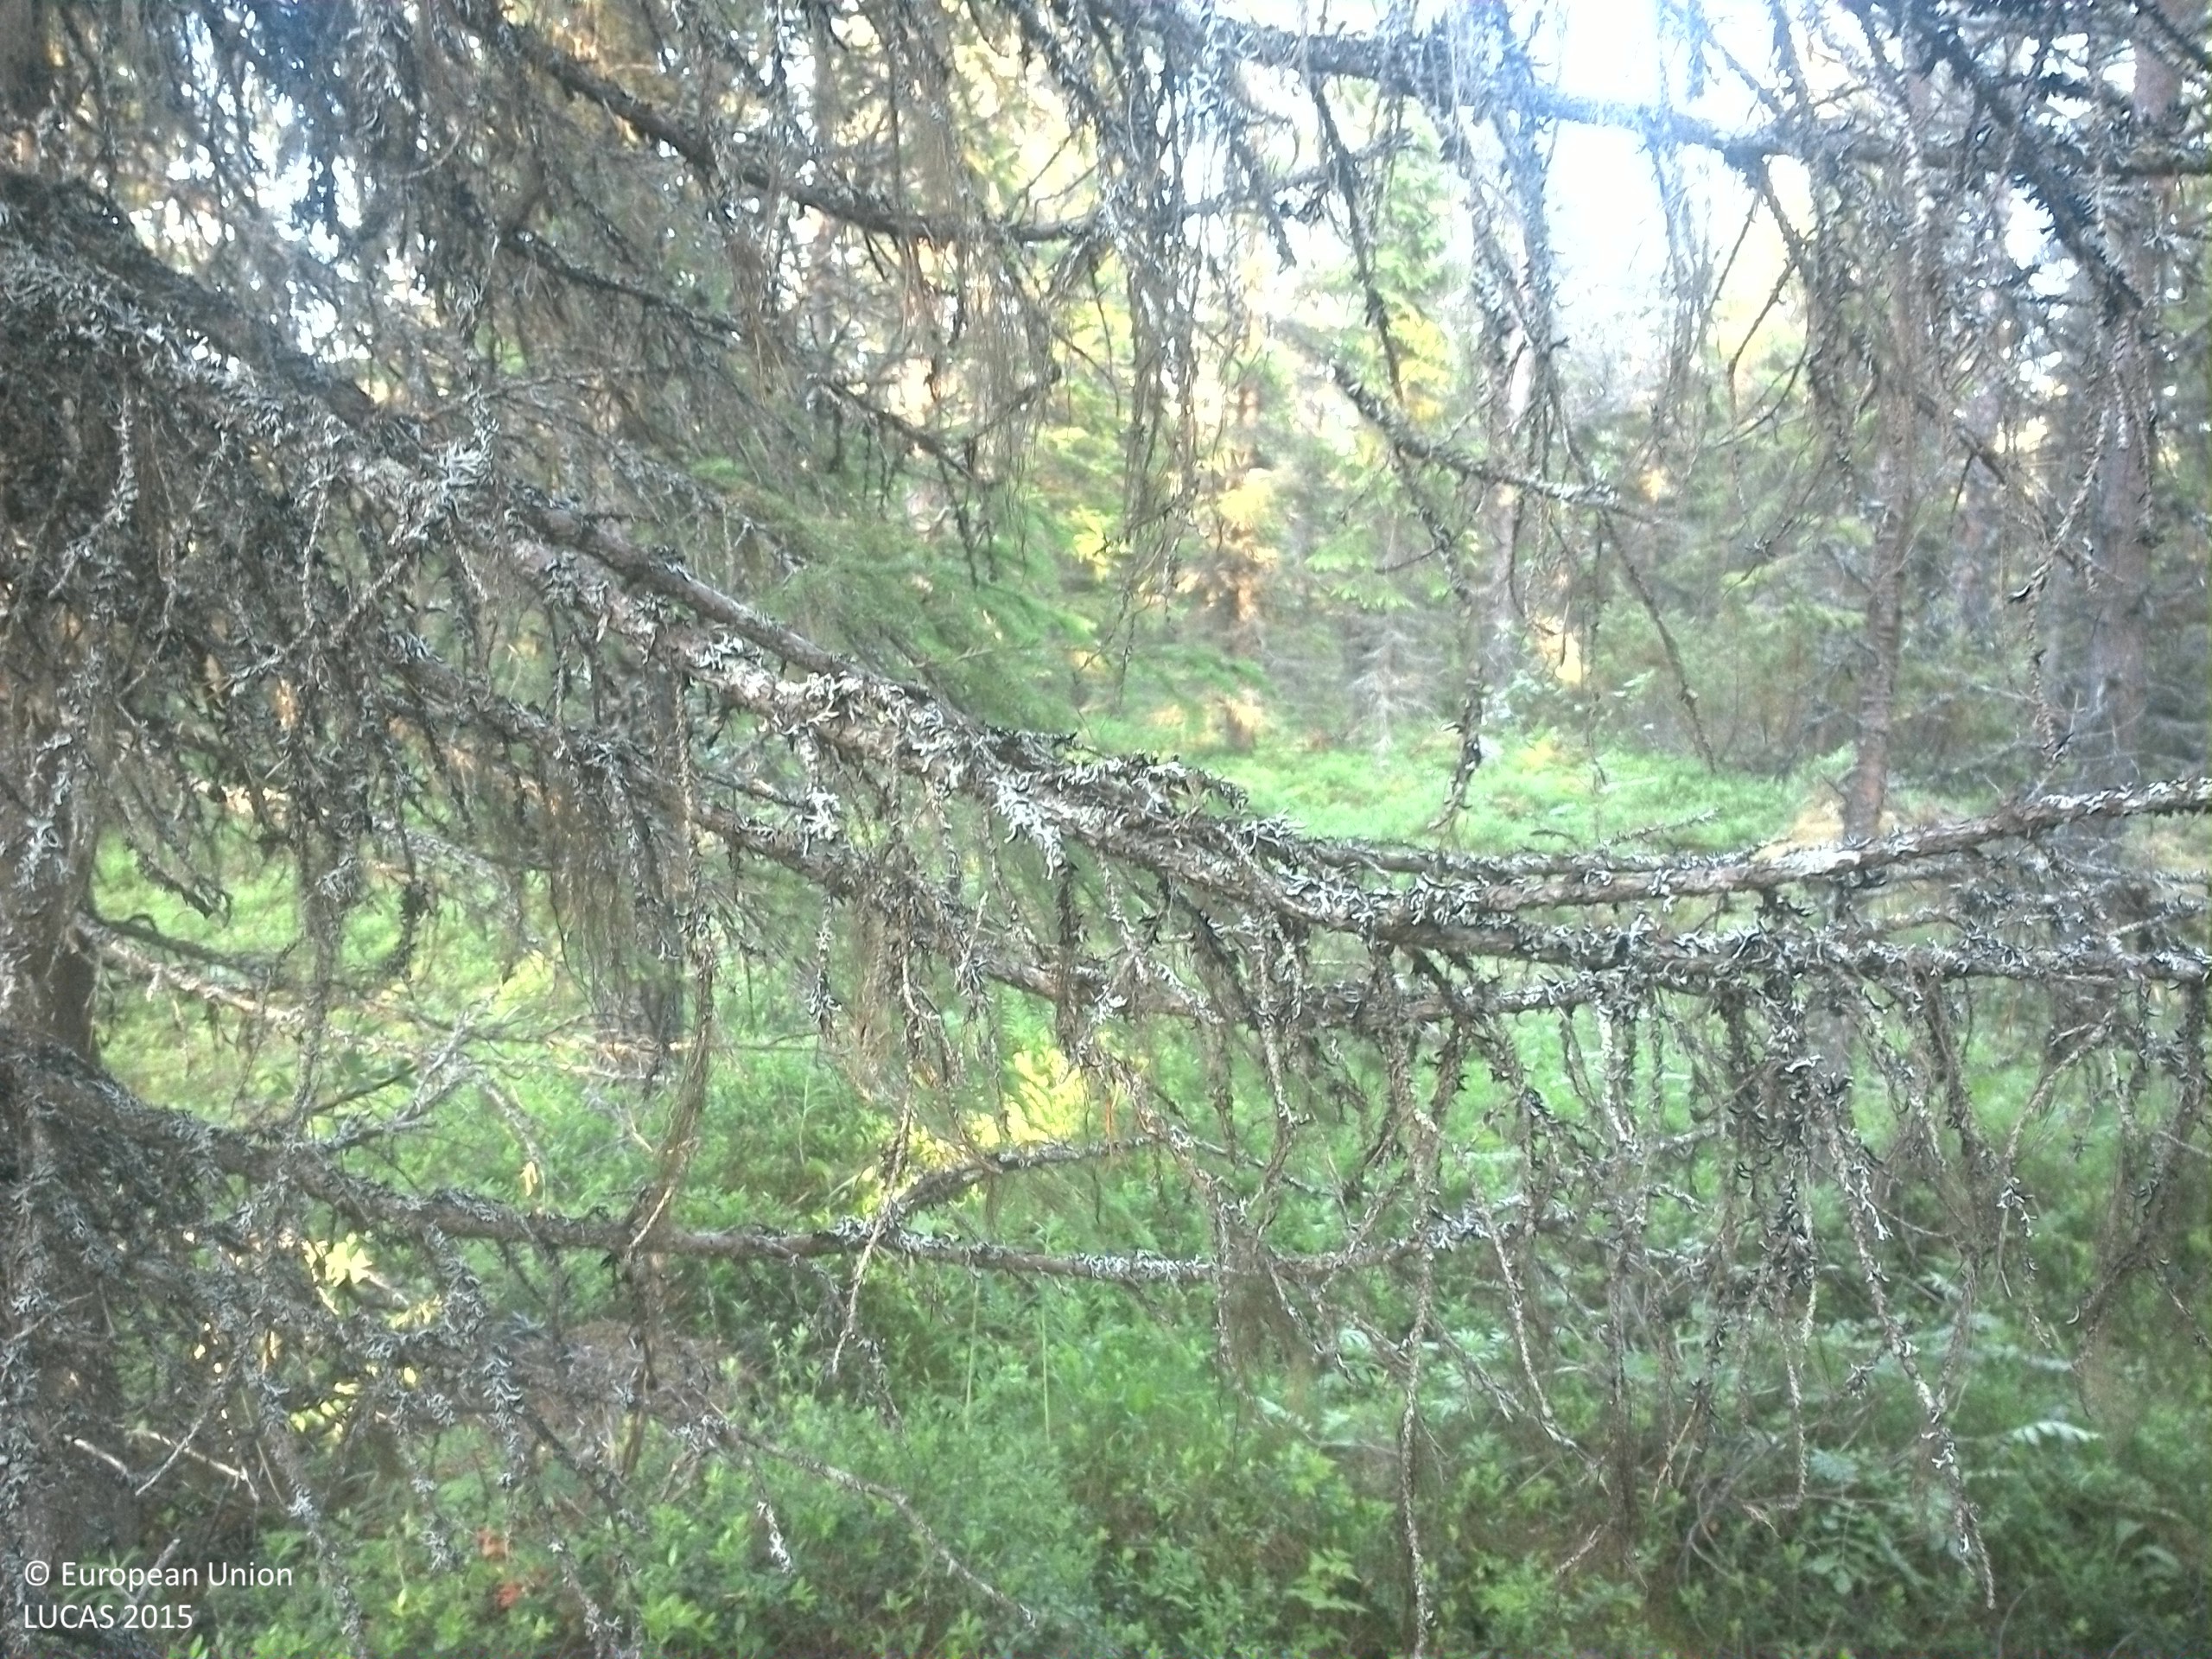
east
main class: Woodland
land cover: Other coniferous woodland
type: boreal forest
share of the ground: 50 - 75 %
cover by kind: coniferous forest trees 60 %, shrubs 30 %, broadleaved forest trees 5 %, herbaceous plants 5 %
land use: Forestry
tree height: > 5 m
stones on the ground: 25 - 50 %
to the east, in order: Other coniferous woodland; Spruce dominated mixed woodland; Rocks and stones; Spruce dominated coniferous woodland; Rocks and stones; Spruce dominated coniferous woodland
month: July
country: SE
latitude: 64.5491
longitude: 15.7046
